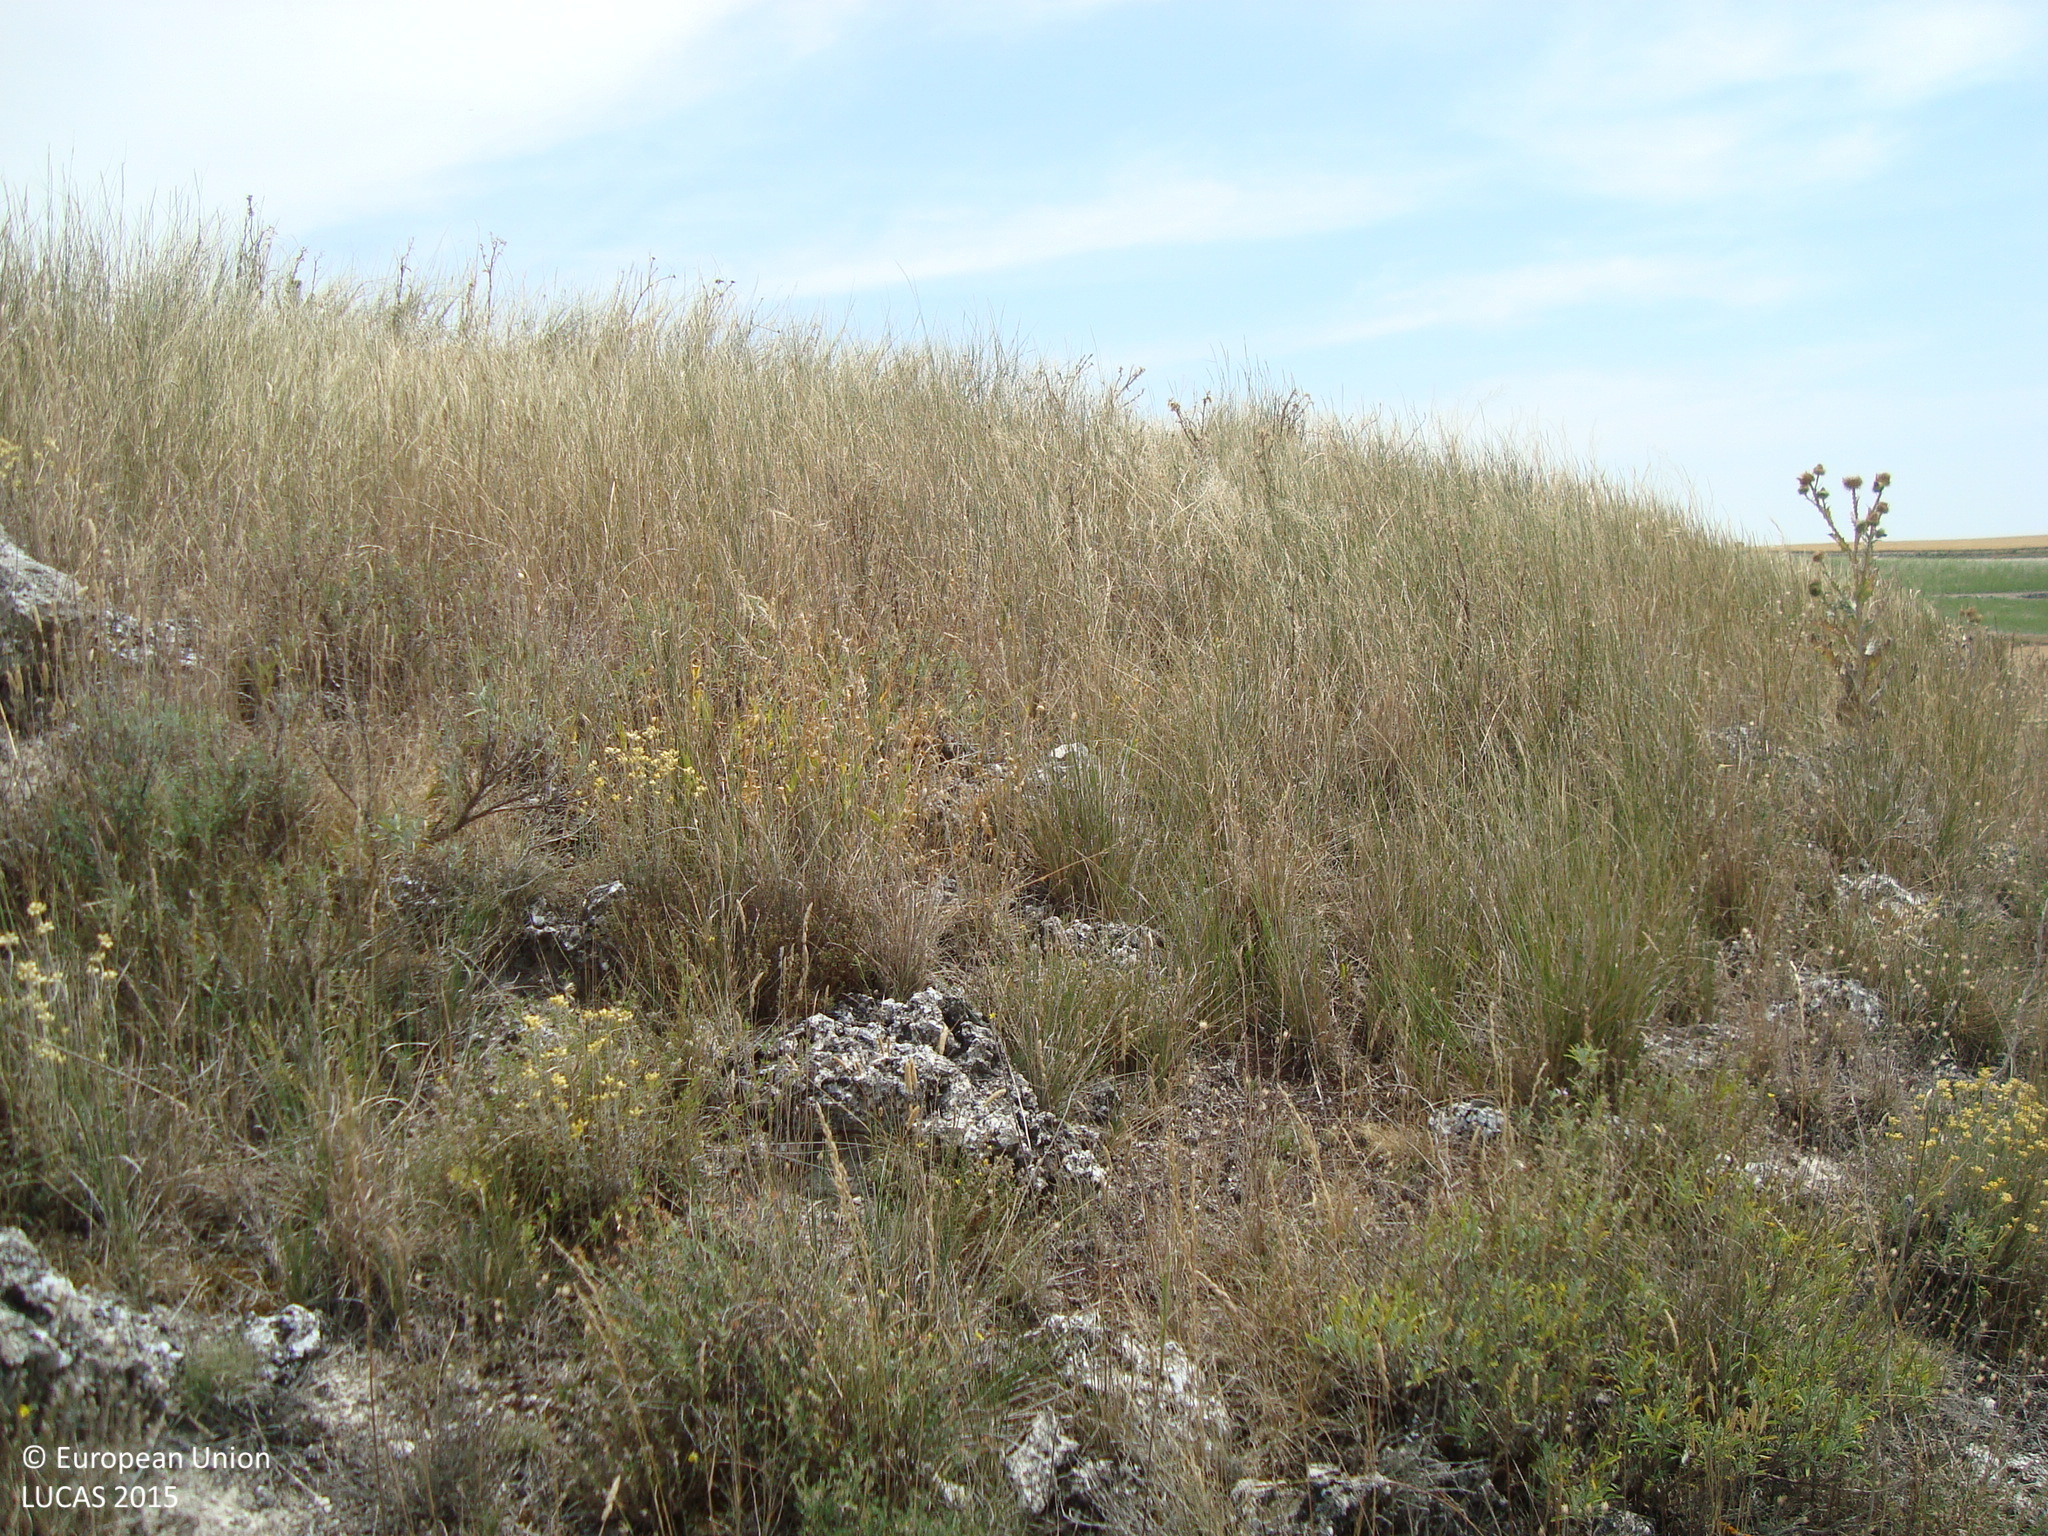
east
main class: Shrubland
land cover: Shrubland without tree cover
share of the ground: 50 - 75 %
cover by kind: shrubs 70 %, unconsolidated bare surface 20 %, herbaceous plants 10 %
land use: Abandoned areas
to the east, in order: Shrubland without tree cover; Grass margins; Barley; Grass margins; Tracks; Grass margins; Barley
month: July
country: ES
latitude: 41.7830
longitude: -4.1506
